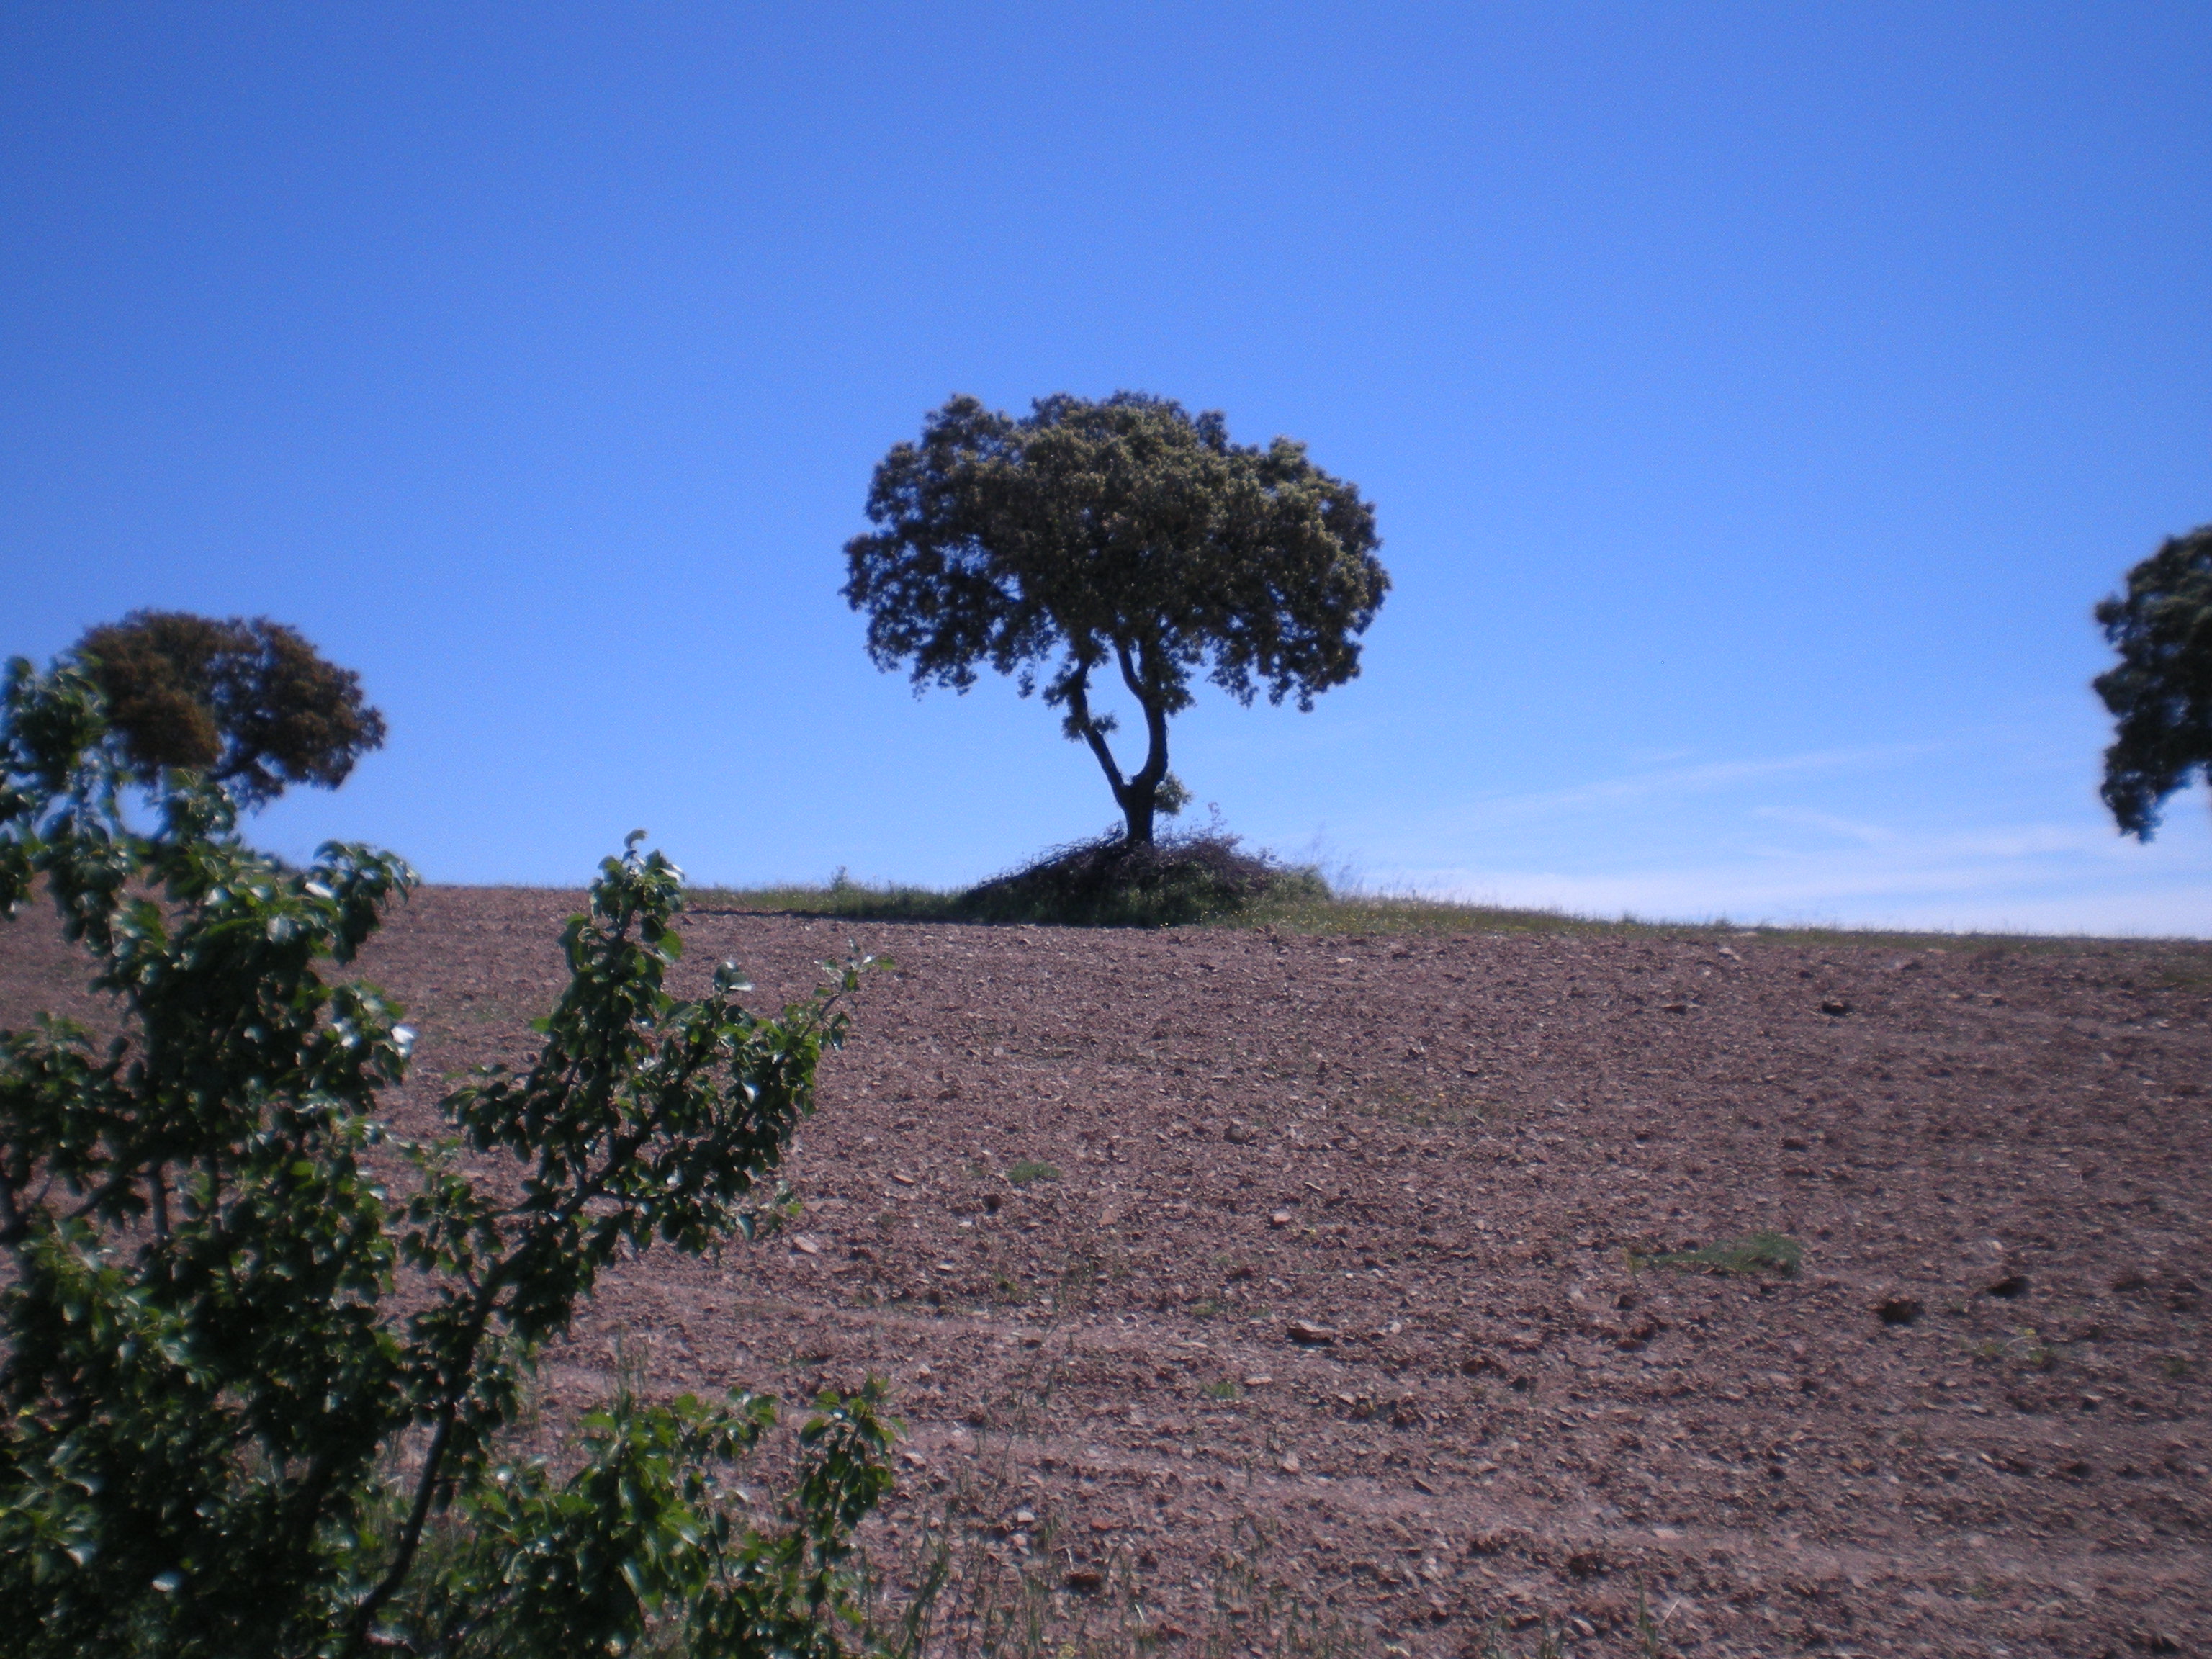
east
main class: Cropland
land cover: Oats
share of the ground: > 75 %
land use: Agriculture (excluding fallow land and kitchen gardens)
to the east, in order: Oats; Grass margins; Other bare soil; Single bushes/trees; Other bare soil; Broadleaved woodland; Tracks; Broadleaved woodland; Grassland with sparse tree/shrub cover; Other bare soil; Broadleaved woodland
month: April
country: ES
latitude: 38.5079
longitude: -2.9500
